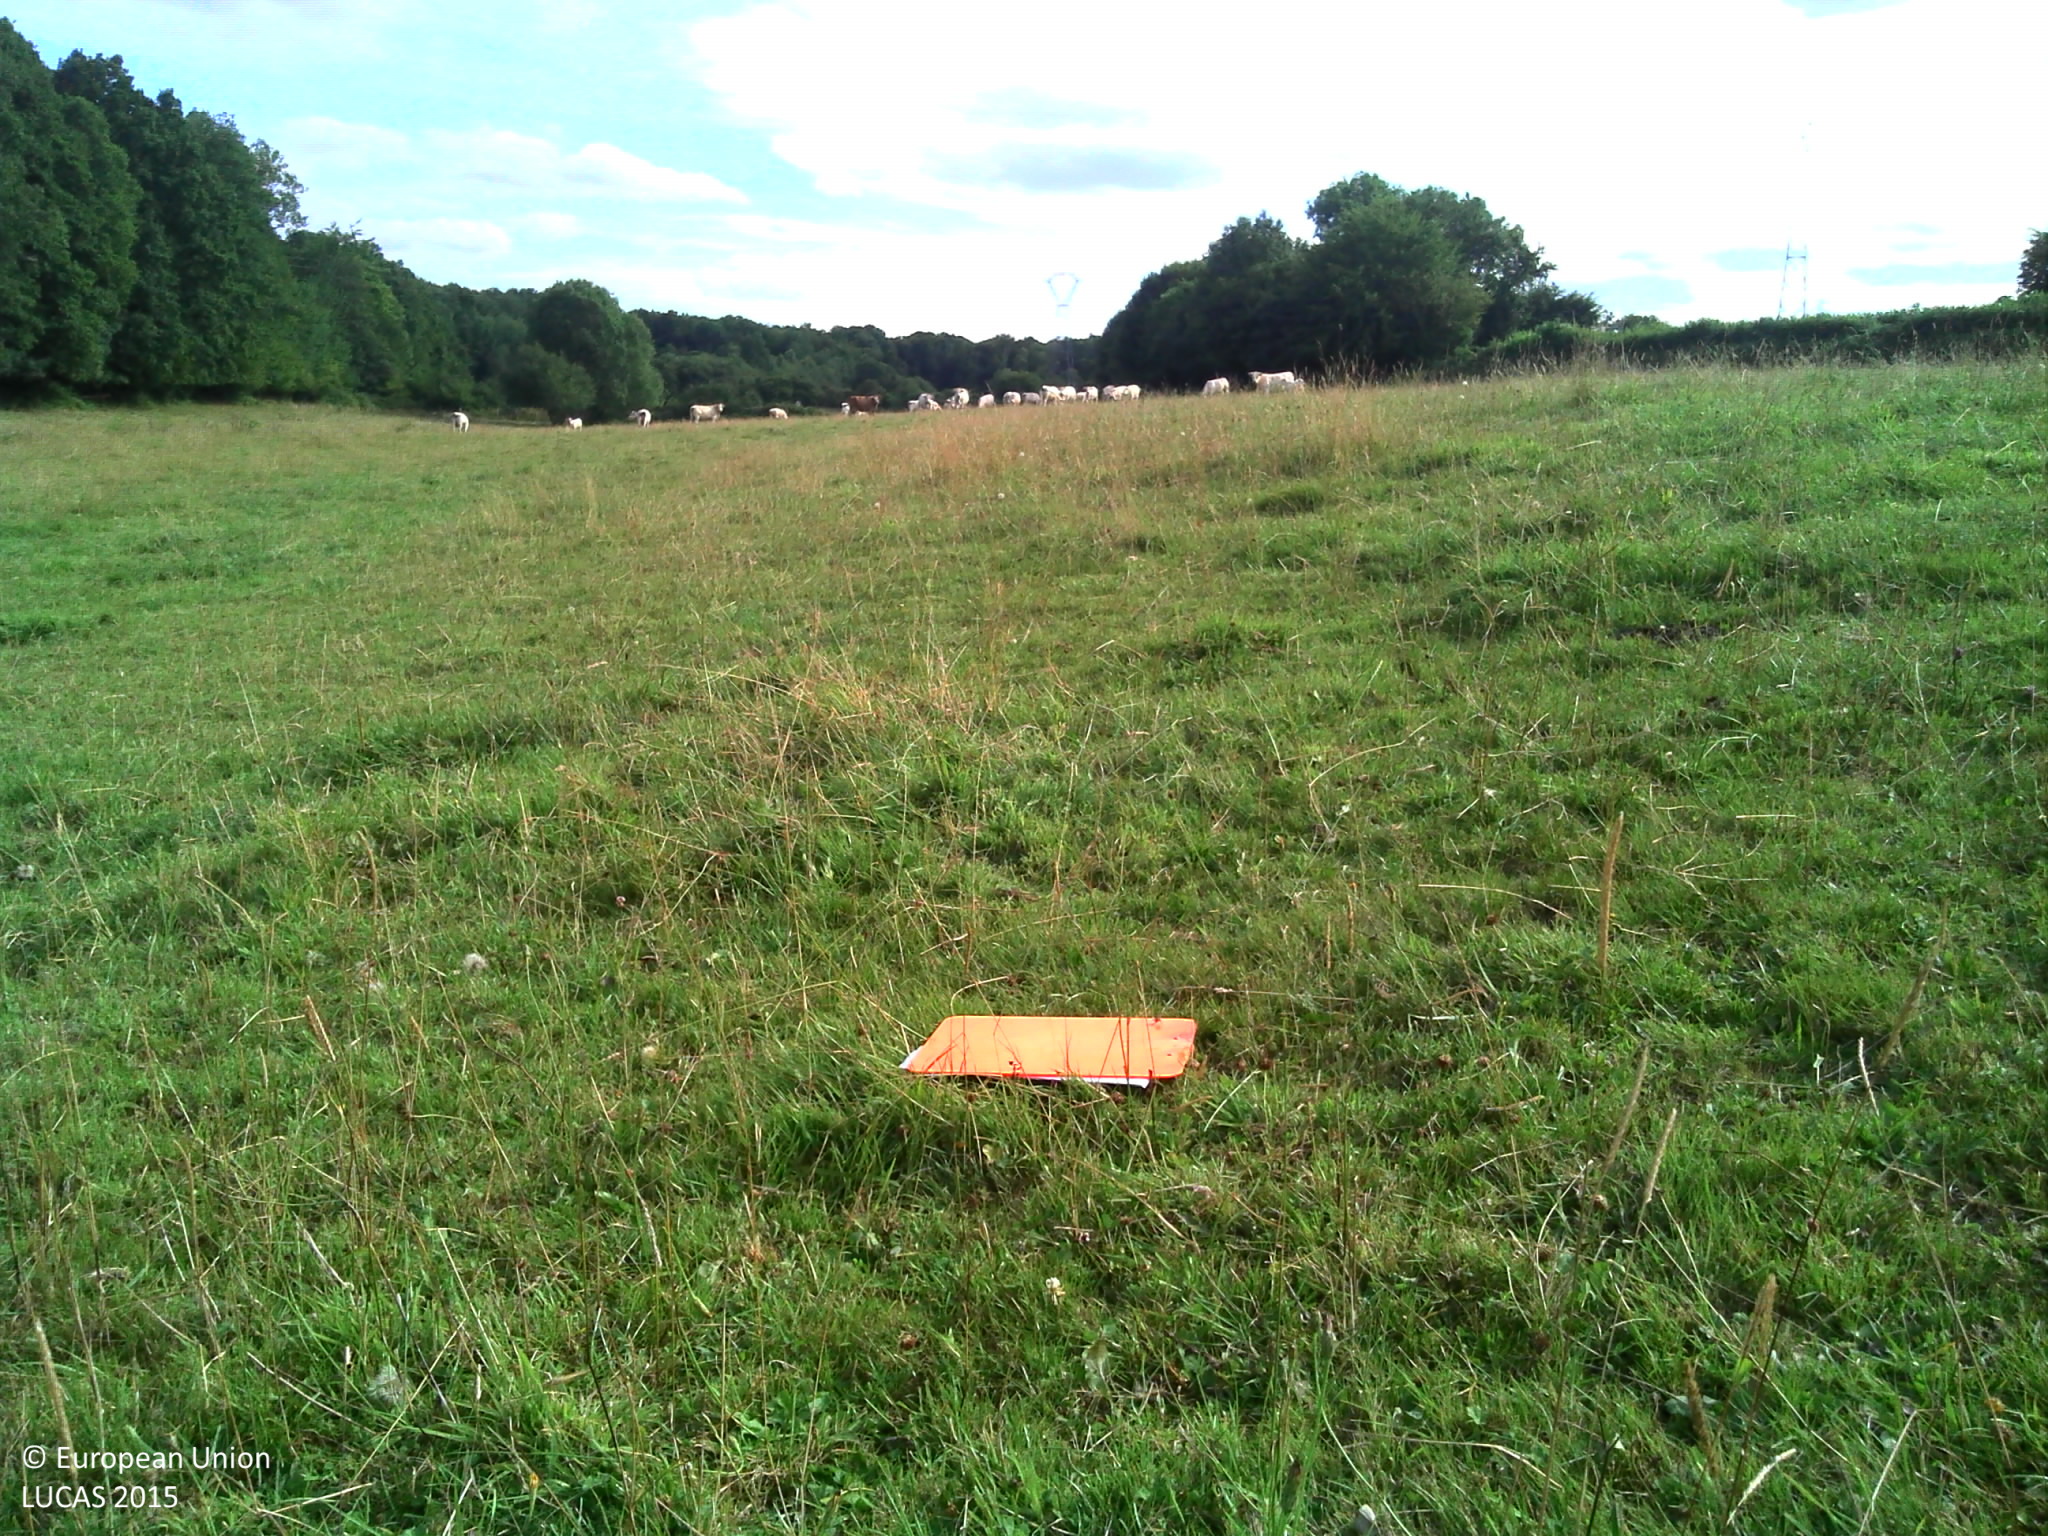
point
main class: Grassland
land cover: Grassland without tree/shrub cover
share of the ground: > 75 %
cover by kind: herbaceous plants 100 %
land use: Agriculture (excluding fallow land and kitchen gardens)
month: July
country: FR
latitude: 48.7005
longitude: 0.5043
